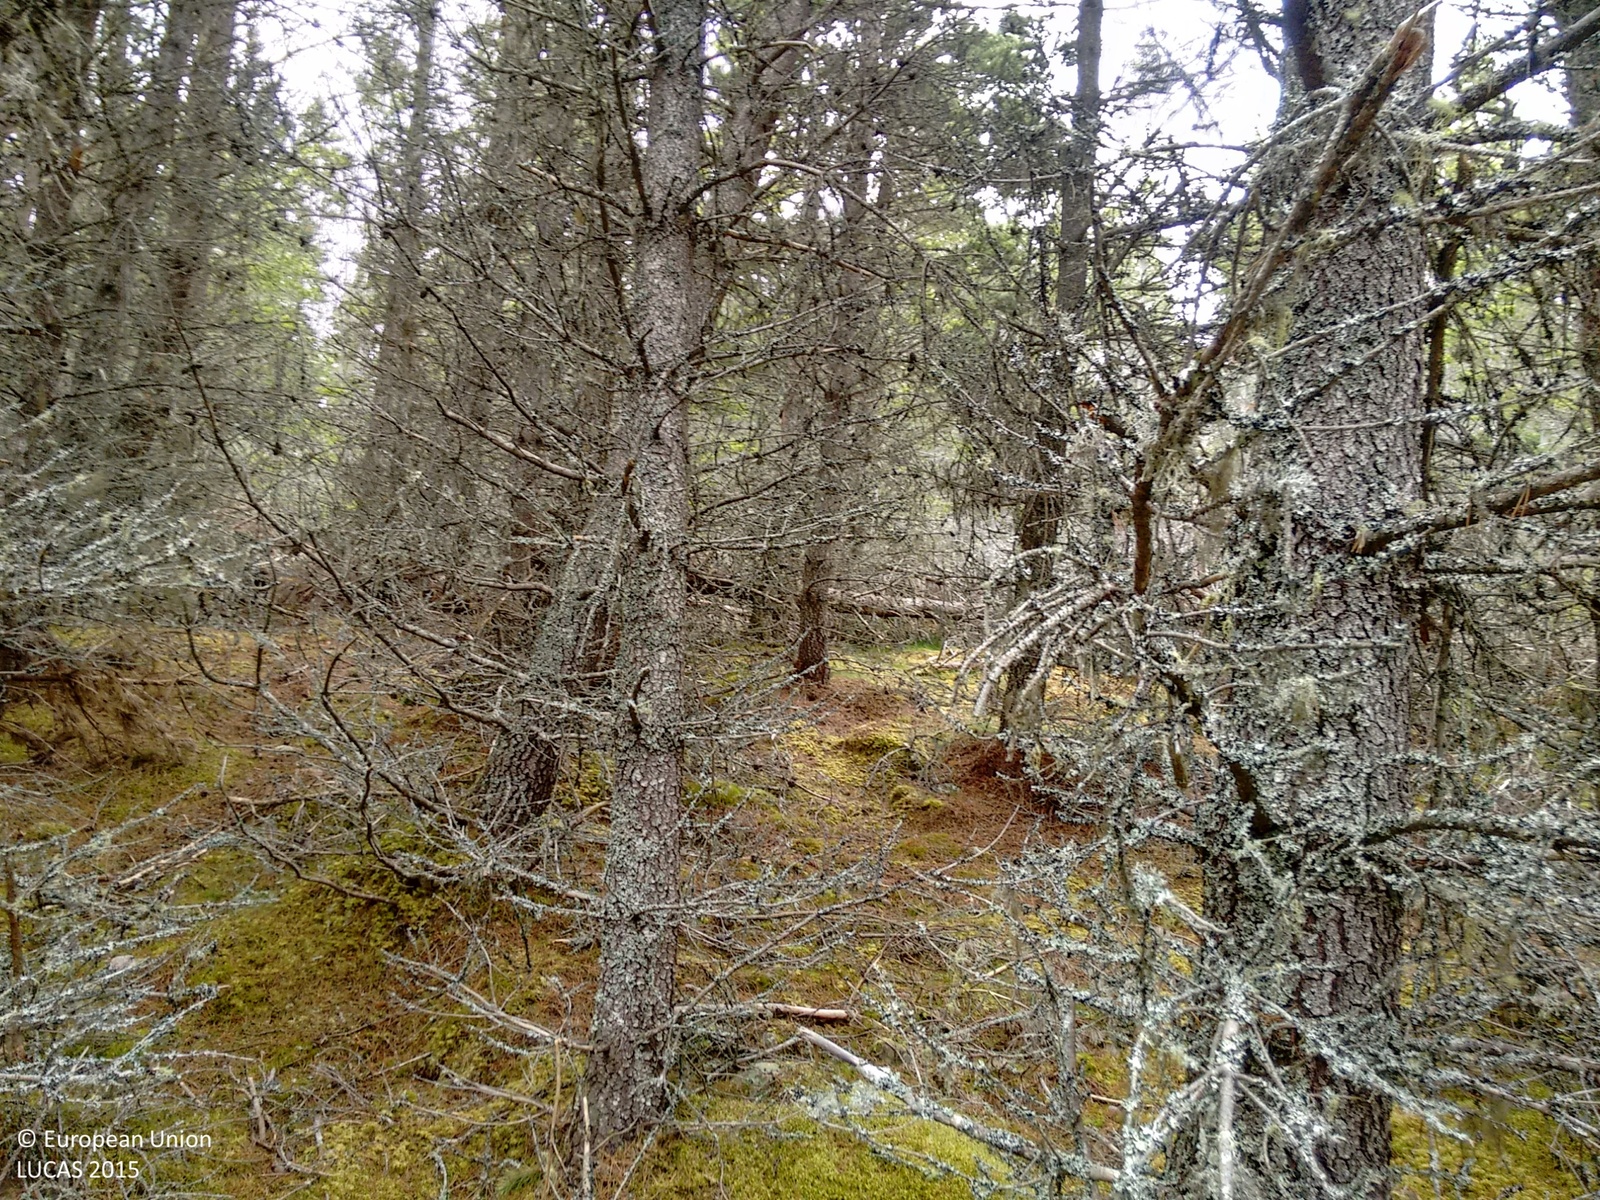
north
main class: Woodland
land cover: Pine dominated coniferous woodland
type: exotic forest
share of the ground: 50 - 75 %
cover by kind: coniferous forest trees 60 %, lichens and mosses 40 %
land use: Forestry
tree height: > 5 m
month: June
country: GB
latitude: 57.2768
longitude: -3.8617
